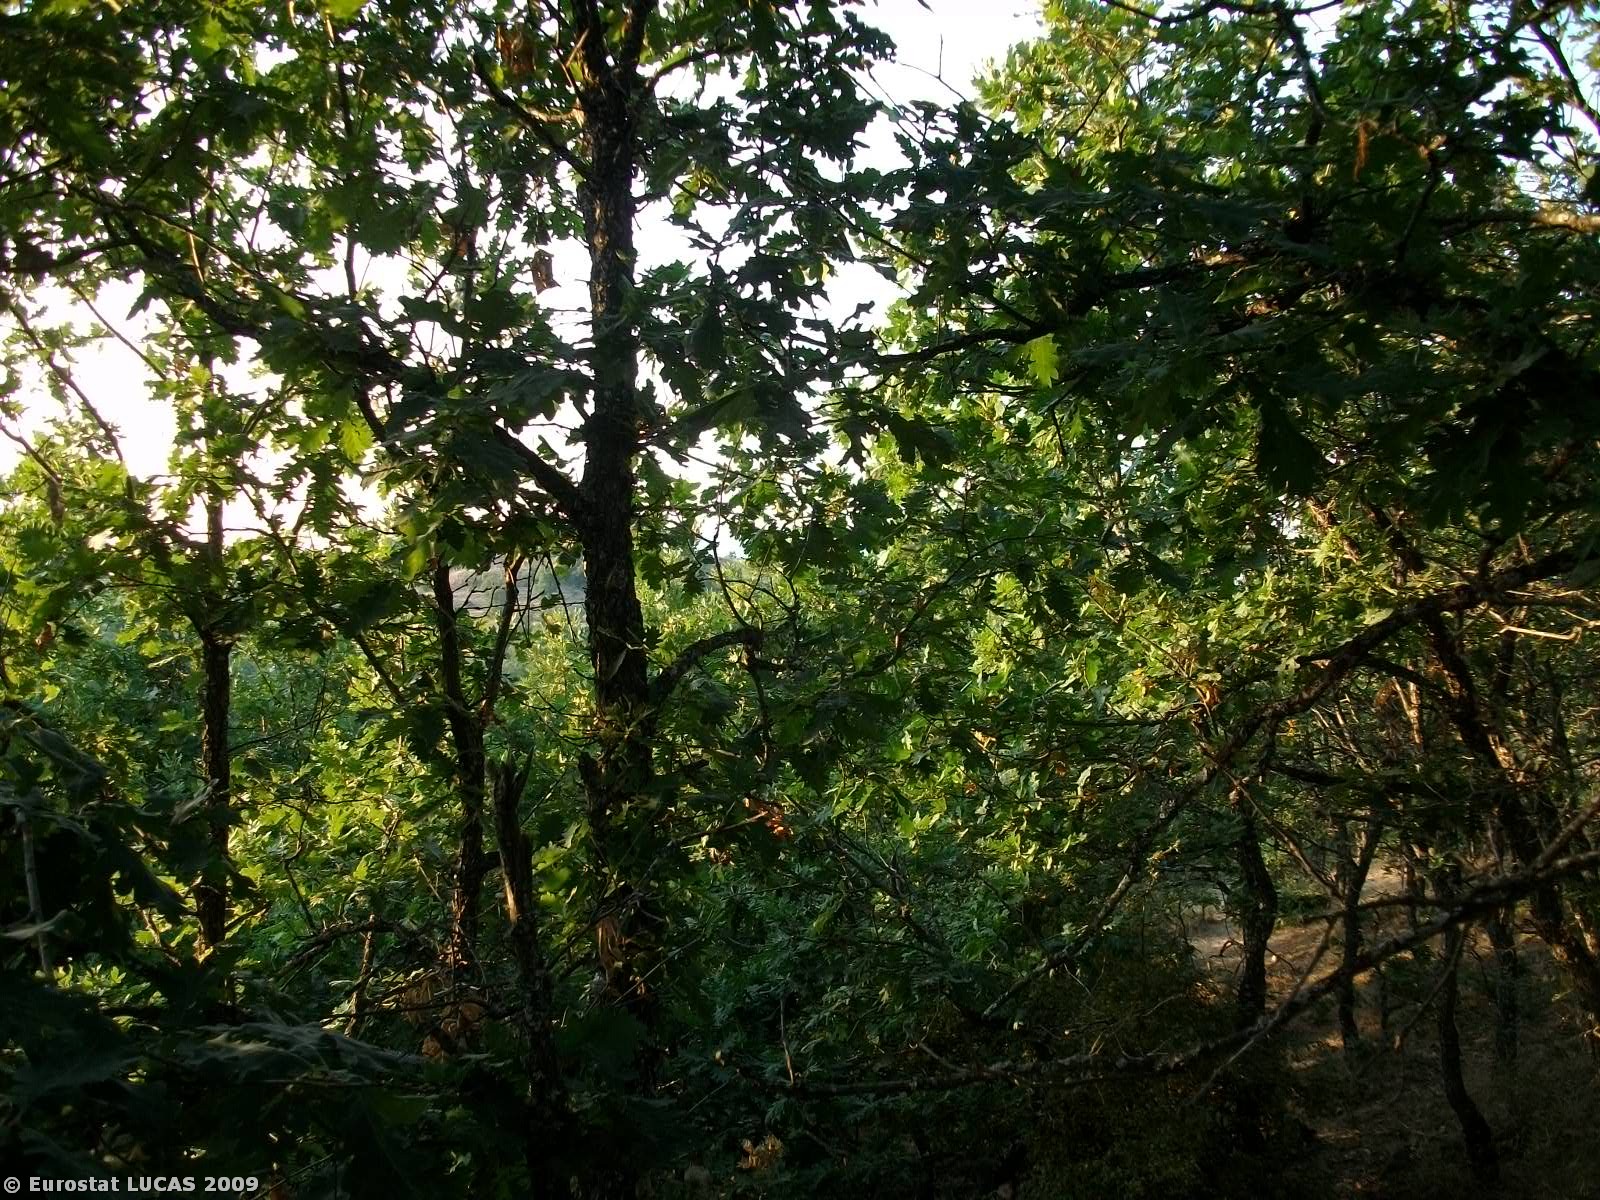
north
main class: Woodland
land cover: Broadleaved woodland
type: thermophilous deciduous forest
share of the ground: > 75 %
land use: Forestry
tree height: > 5 m
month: July
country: GR
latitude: 39.8502
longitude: 21.7562
